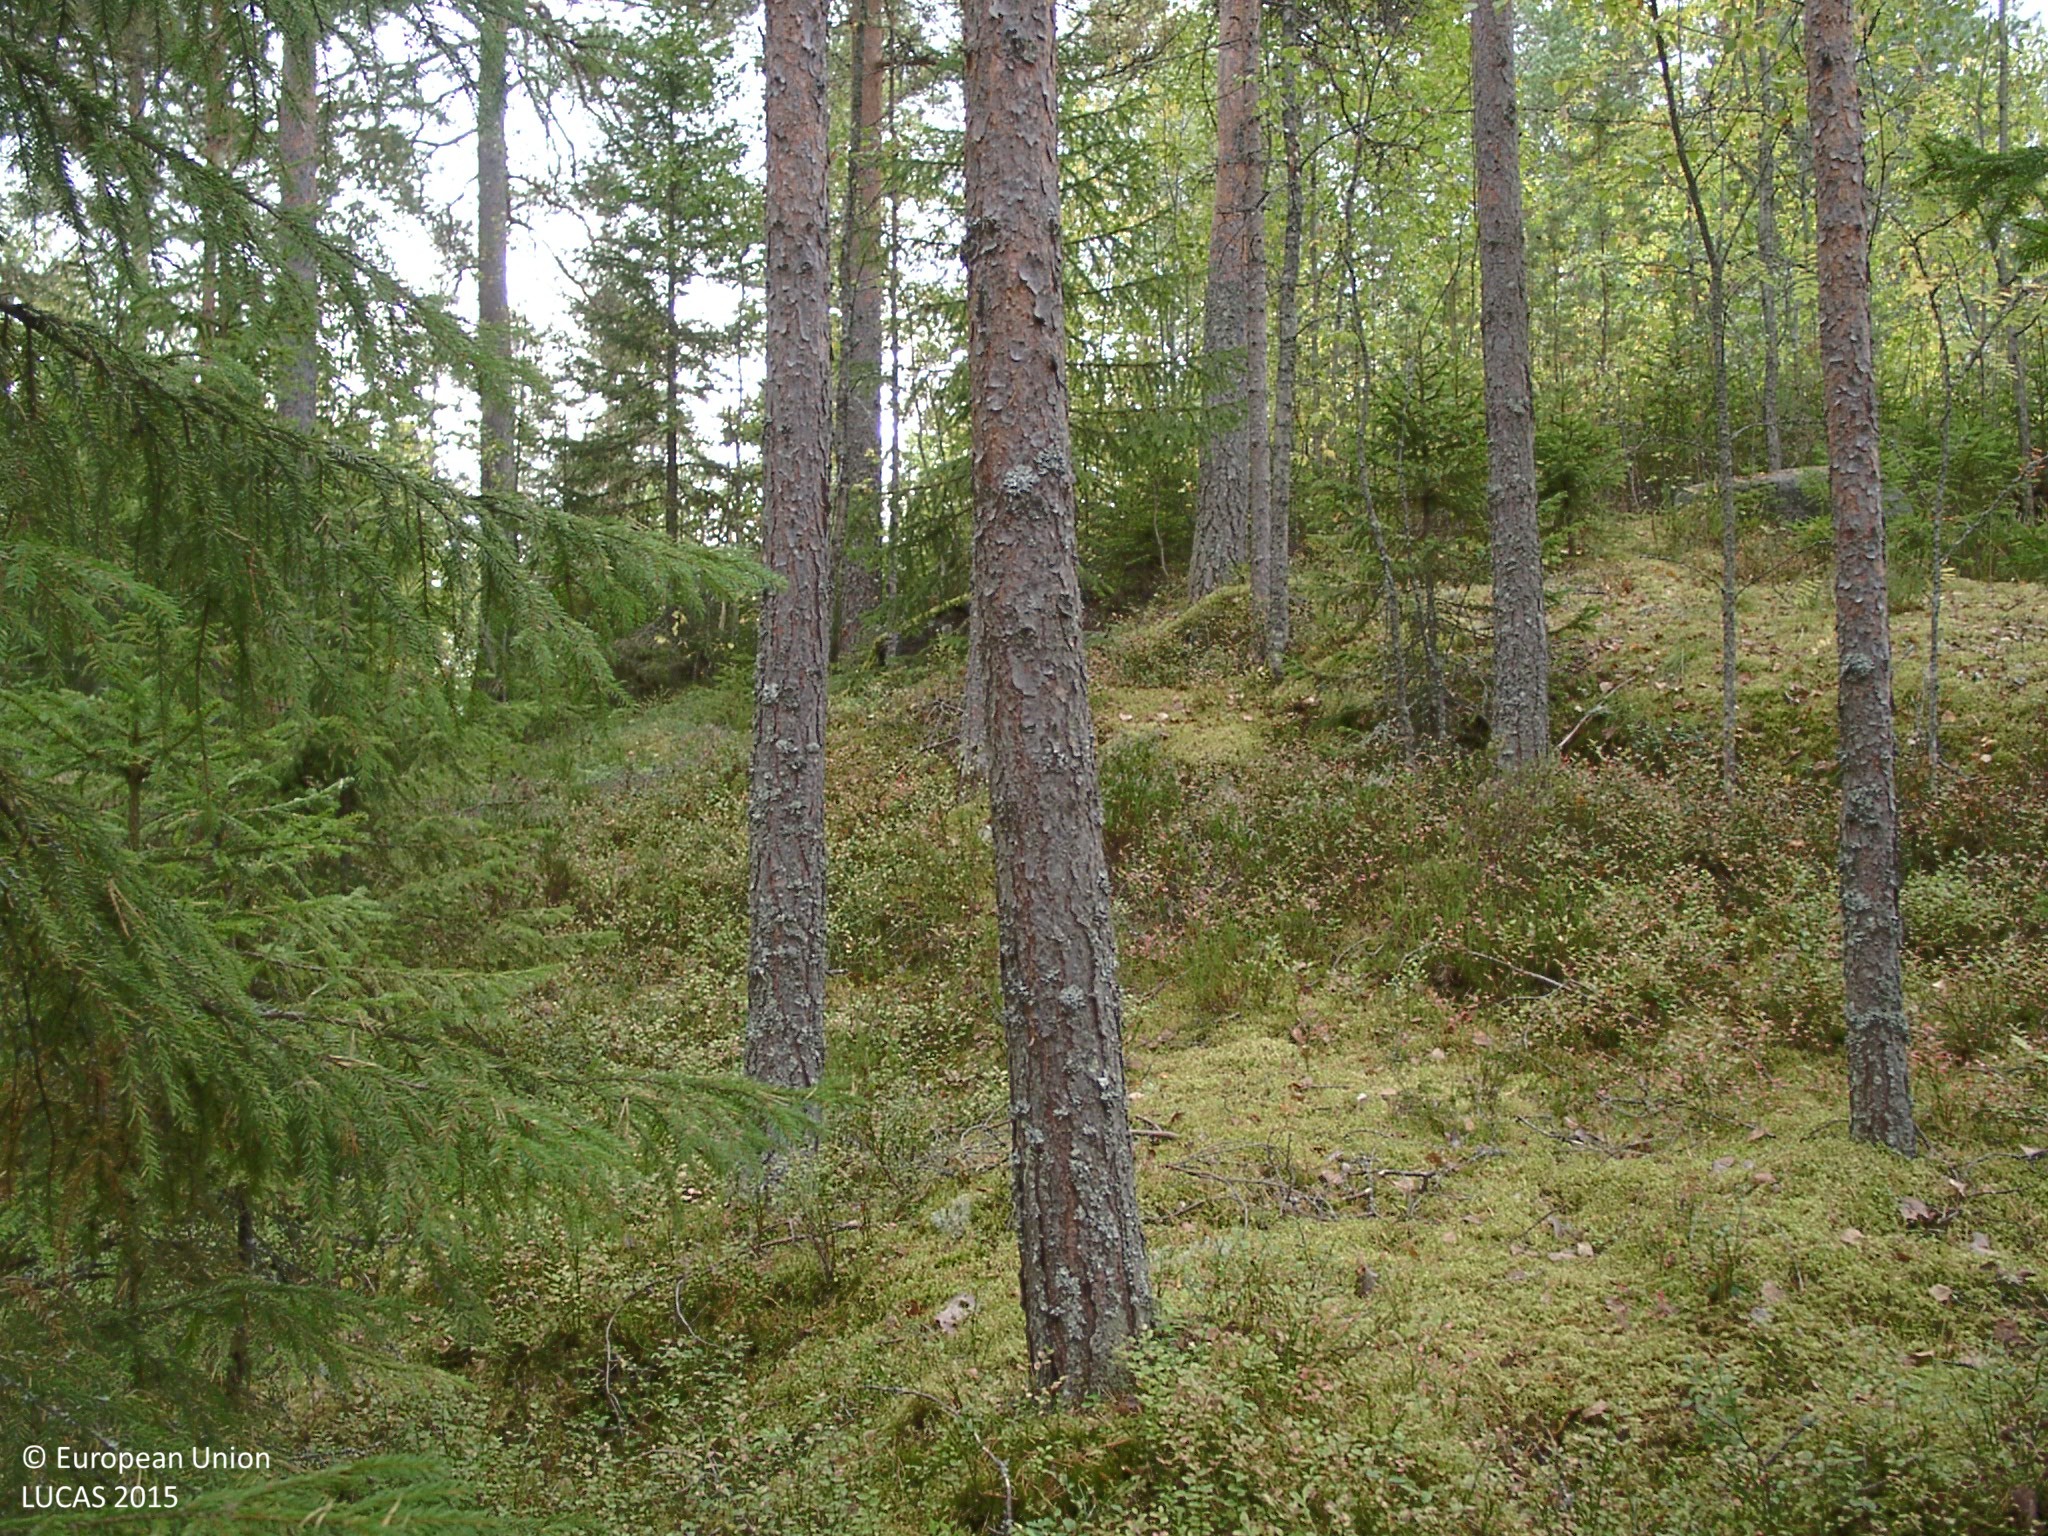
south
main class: Woodland
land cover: Pine dominated coniferous woodland
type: boreal forest
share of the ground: > 75 %
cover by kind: coniferous forest trees 80 %, lichens and mosses 10 %, broadleaved forest trees 5 %, shrubs 5 %
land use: Forestry
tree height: > 5 m
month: September
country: FI
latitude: 62.5581
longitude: 25.8553
